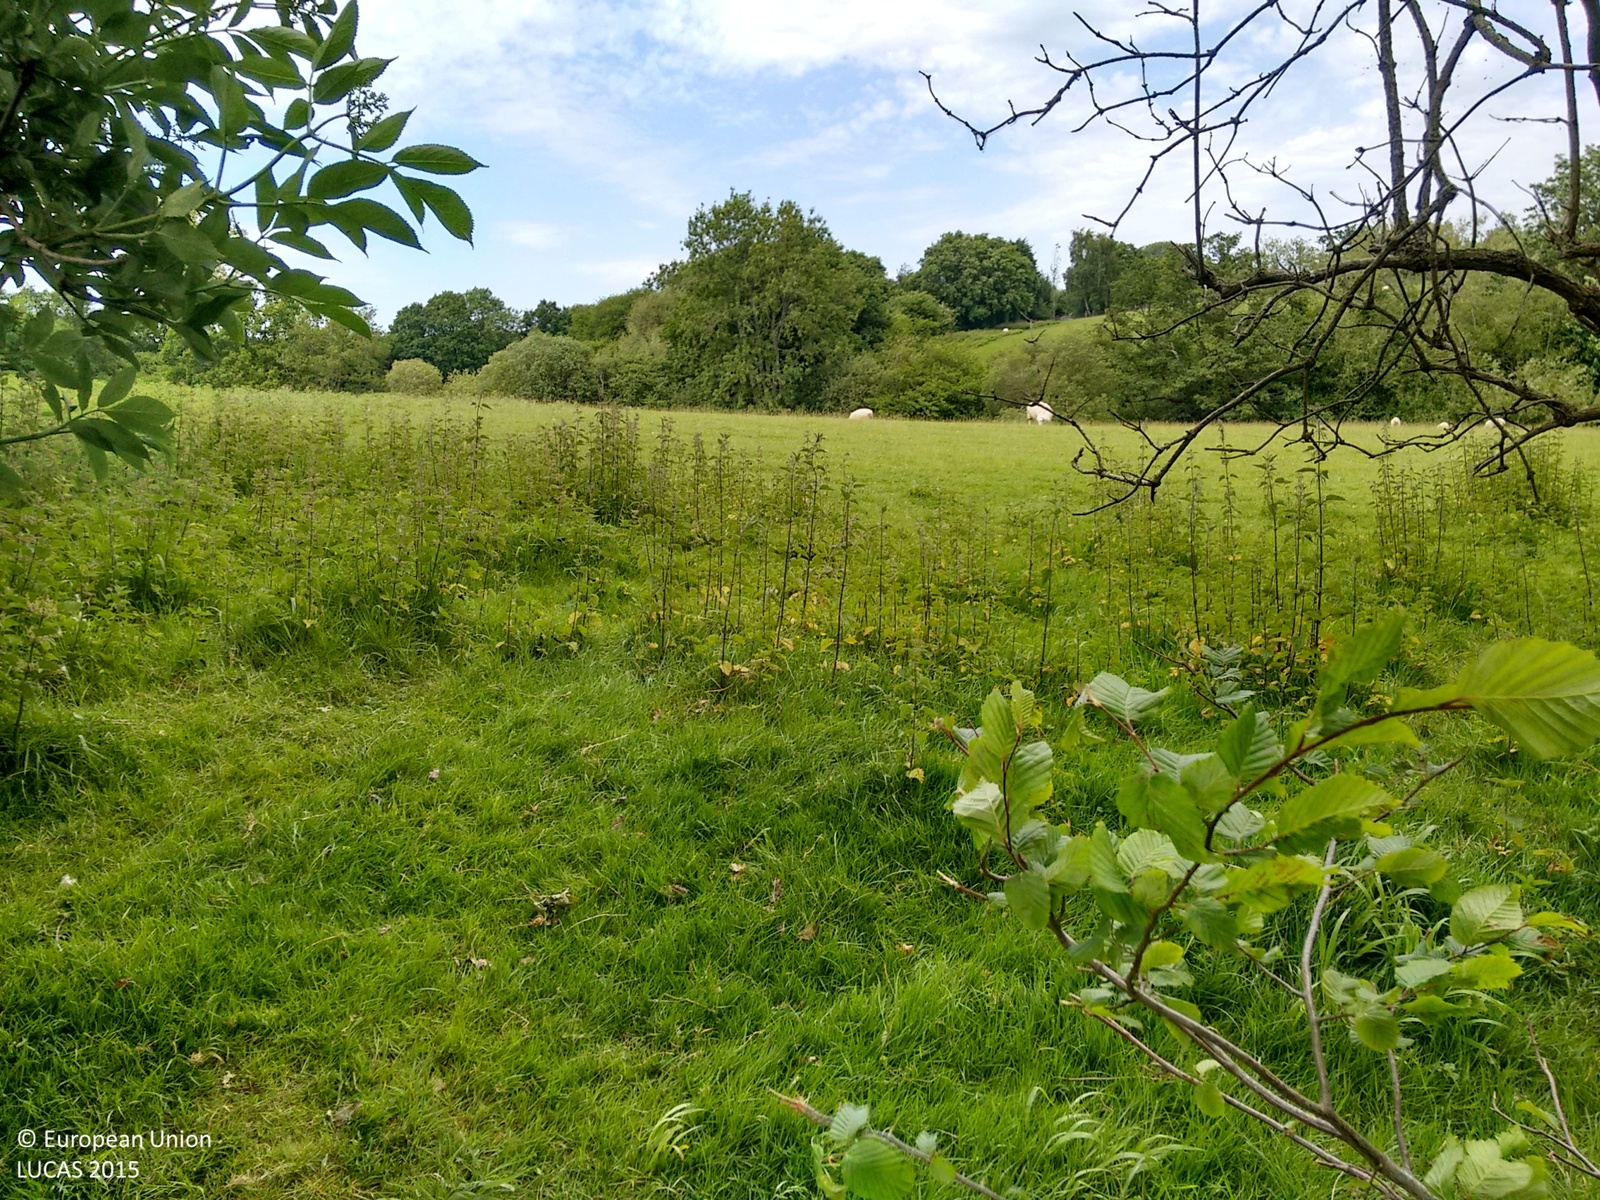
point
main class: Grassland
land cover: Grassland without tree/shrub cover
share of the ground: > 75 %
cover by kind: herbaceous plants 100 %
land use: Agriculture (excluding fallow land and kitchen gardens)
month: June
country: GB
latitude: 51.0824
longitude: 0.6231
